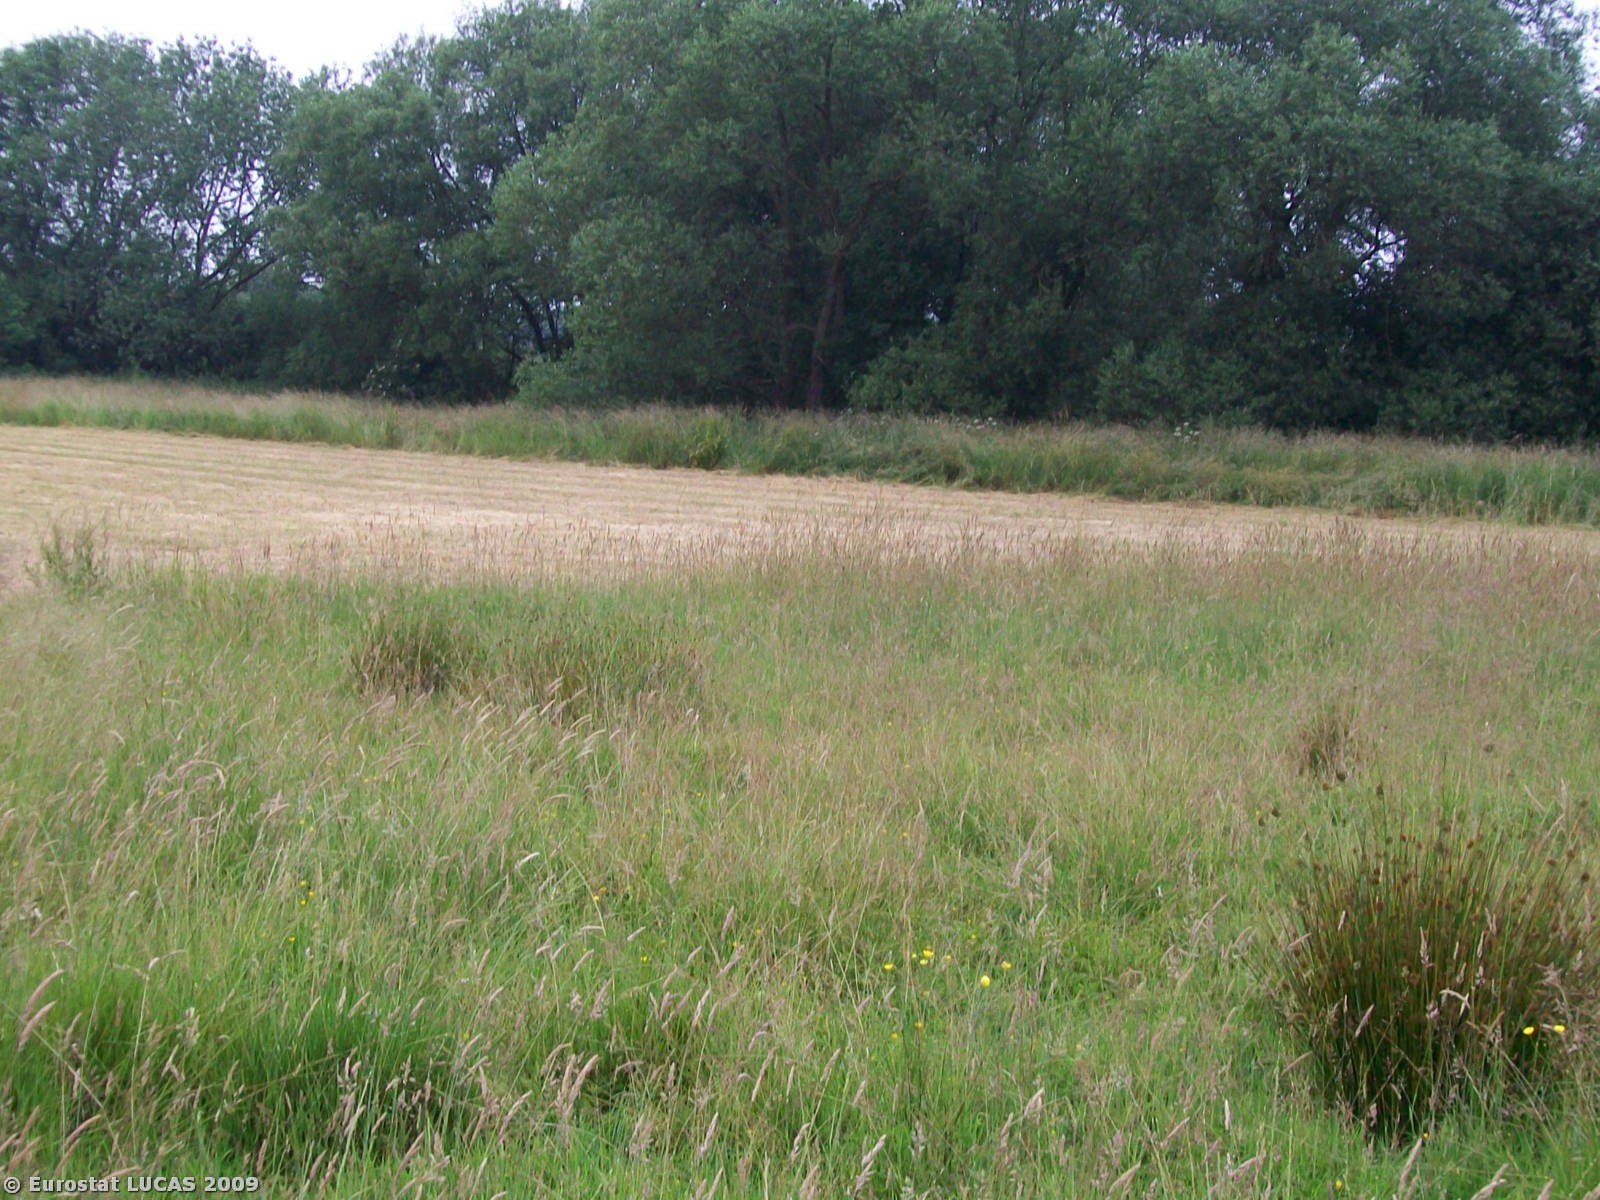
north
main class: Grassland
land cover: Grassland without tree/shrub cover
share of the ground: < 10 %
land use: Agriculture (excluding fallow land and kitchen gardens)
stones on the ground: < 10 %
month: July
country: GB
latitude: 53.8070
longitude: -1.3917
